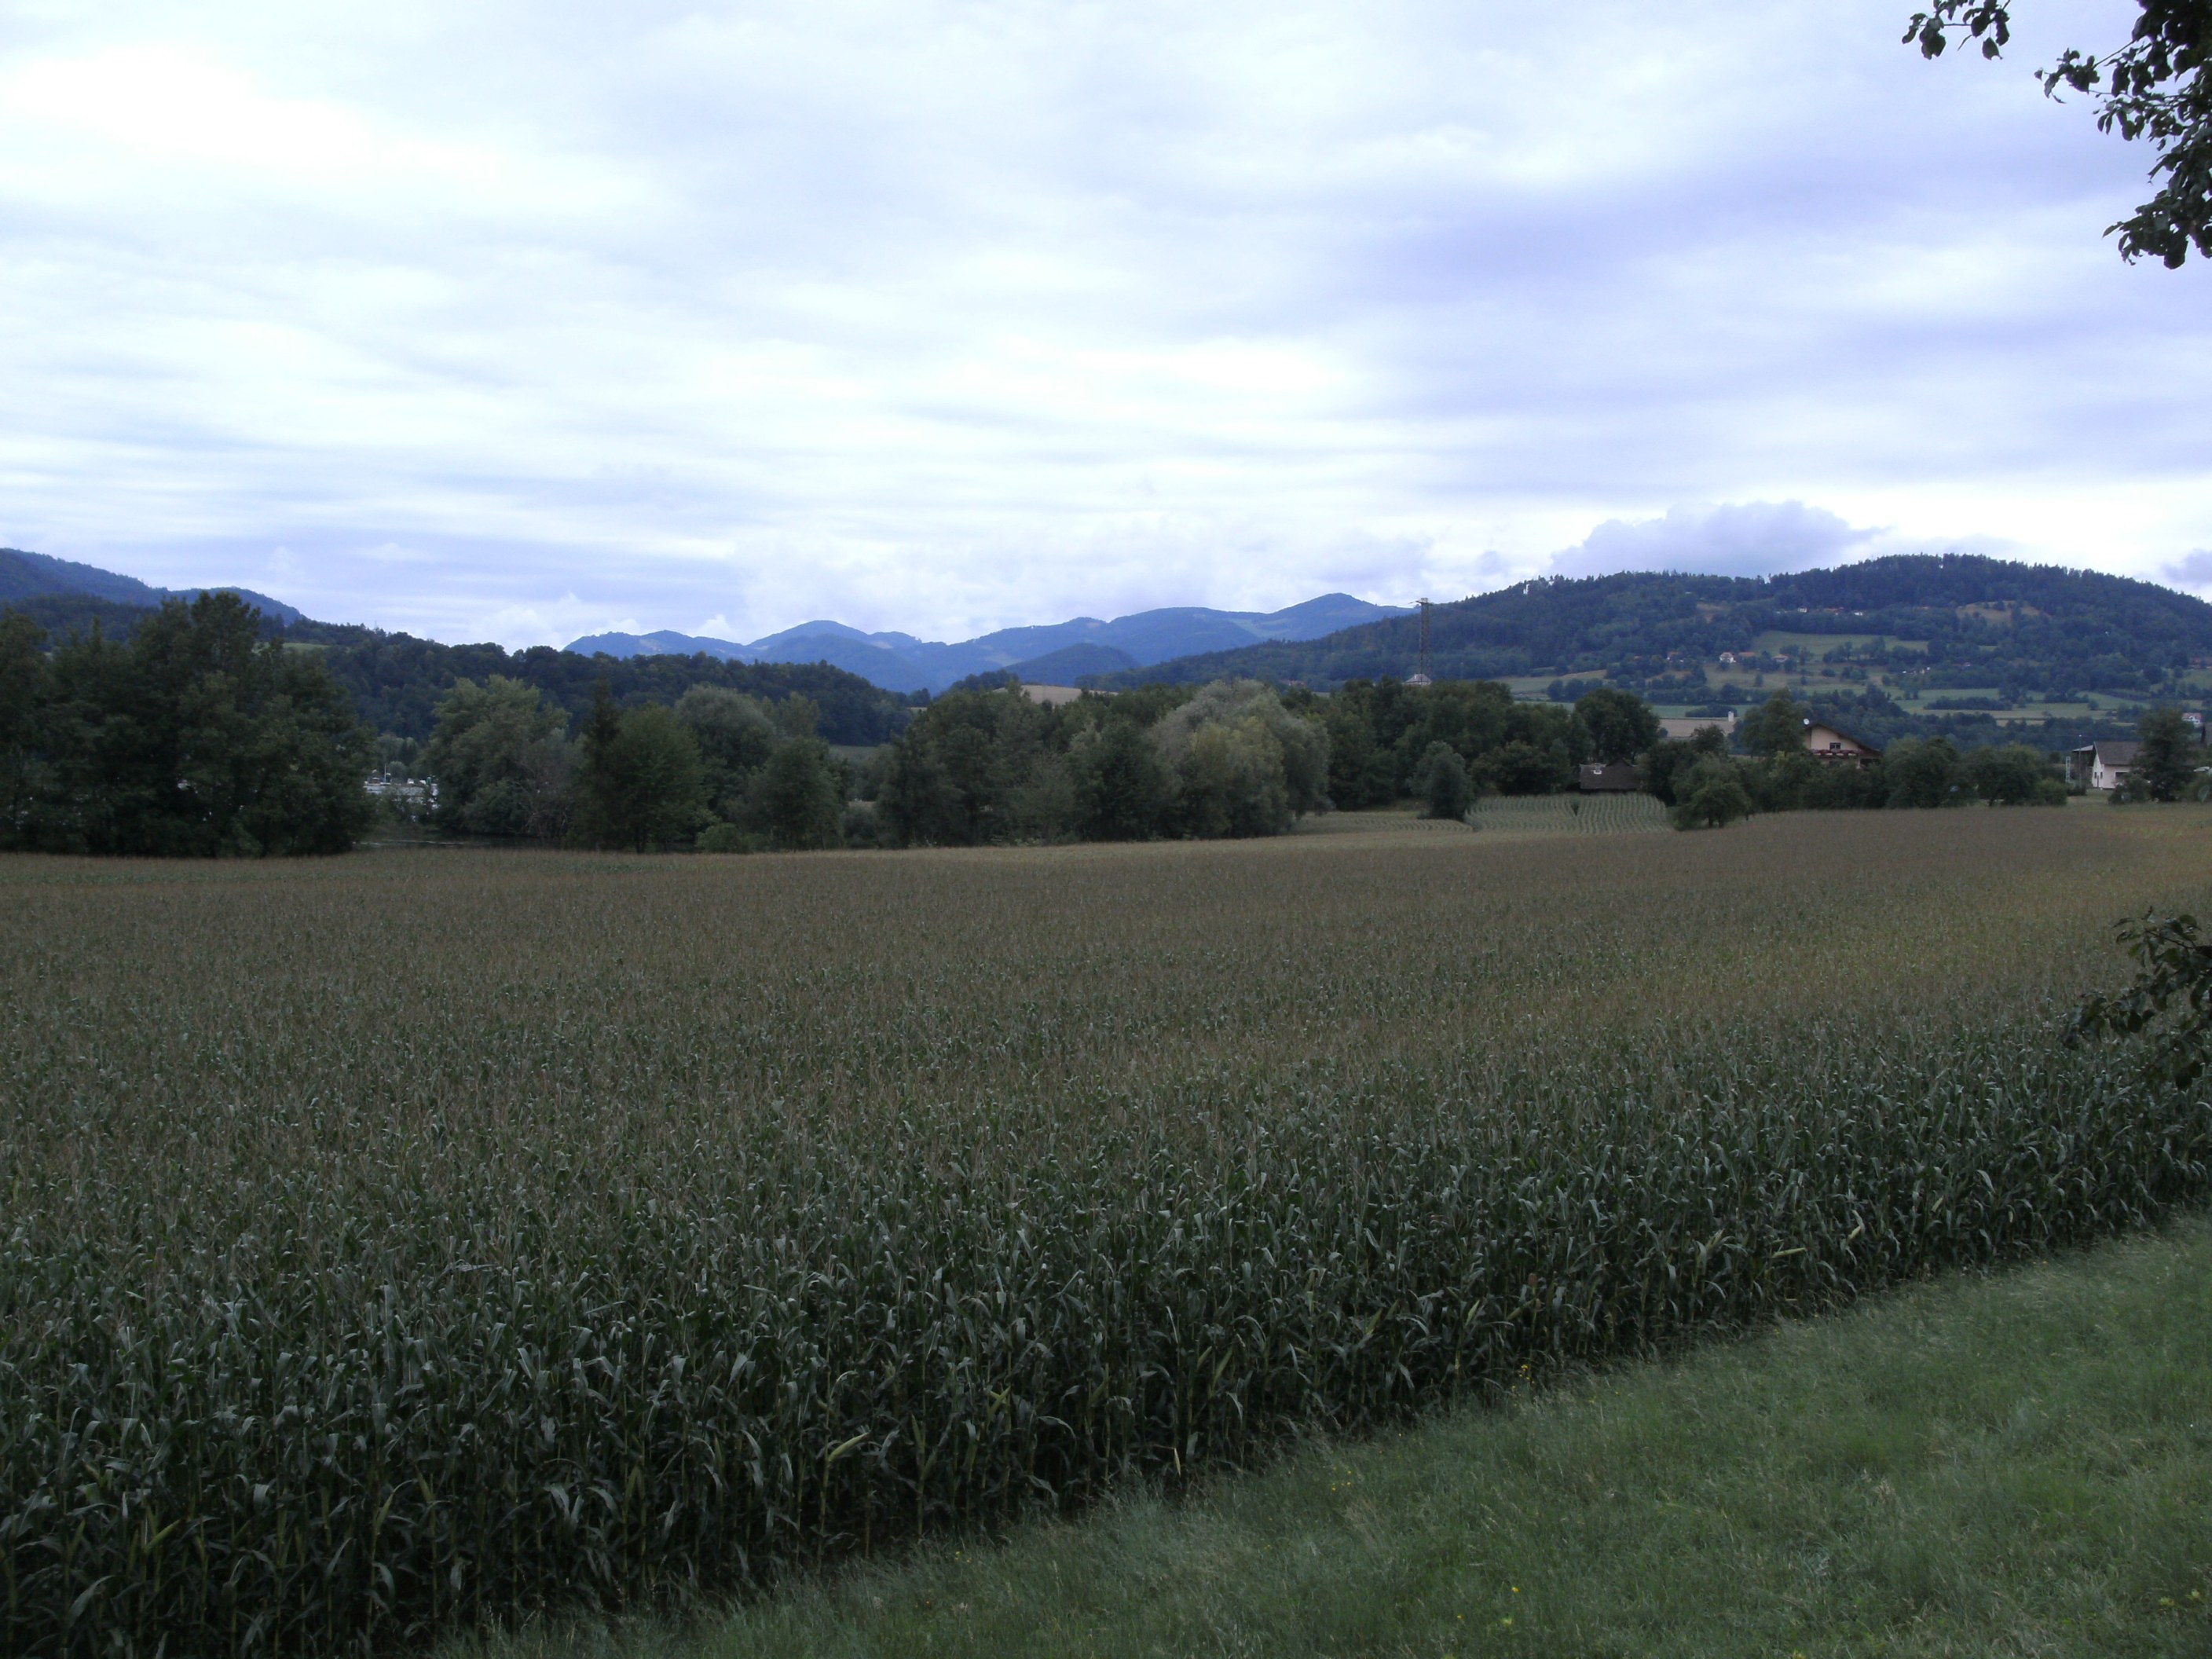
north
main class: Cropland
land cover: Maize
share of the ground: > 75 %
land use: Agriculture (excluding fallow land and kitchen gardens)
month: July
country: AT
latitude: 46.6319
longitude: 14.5824
